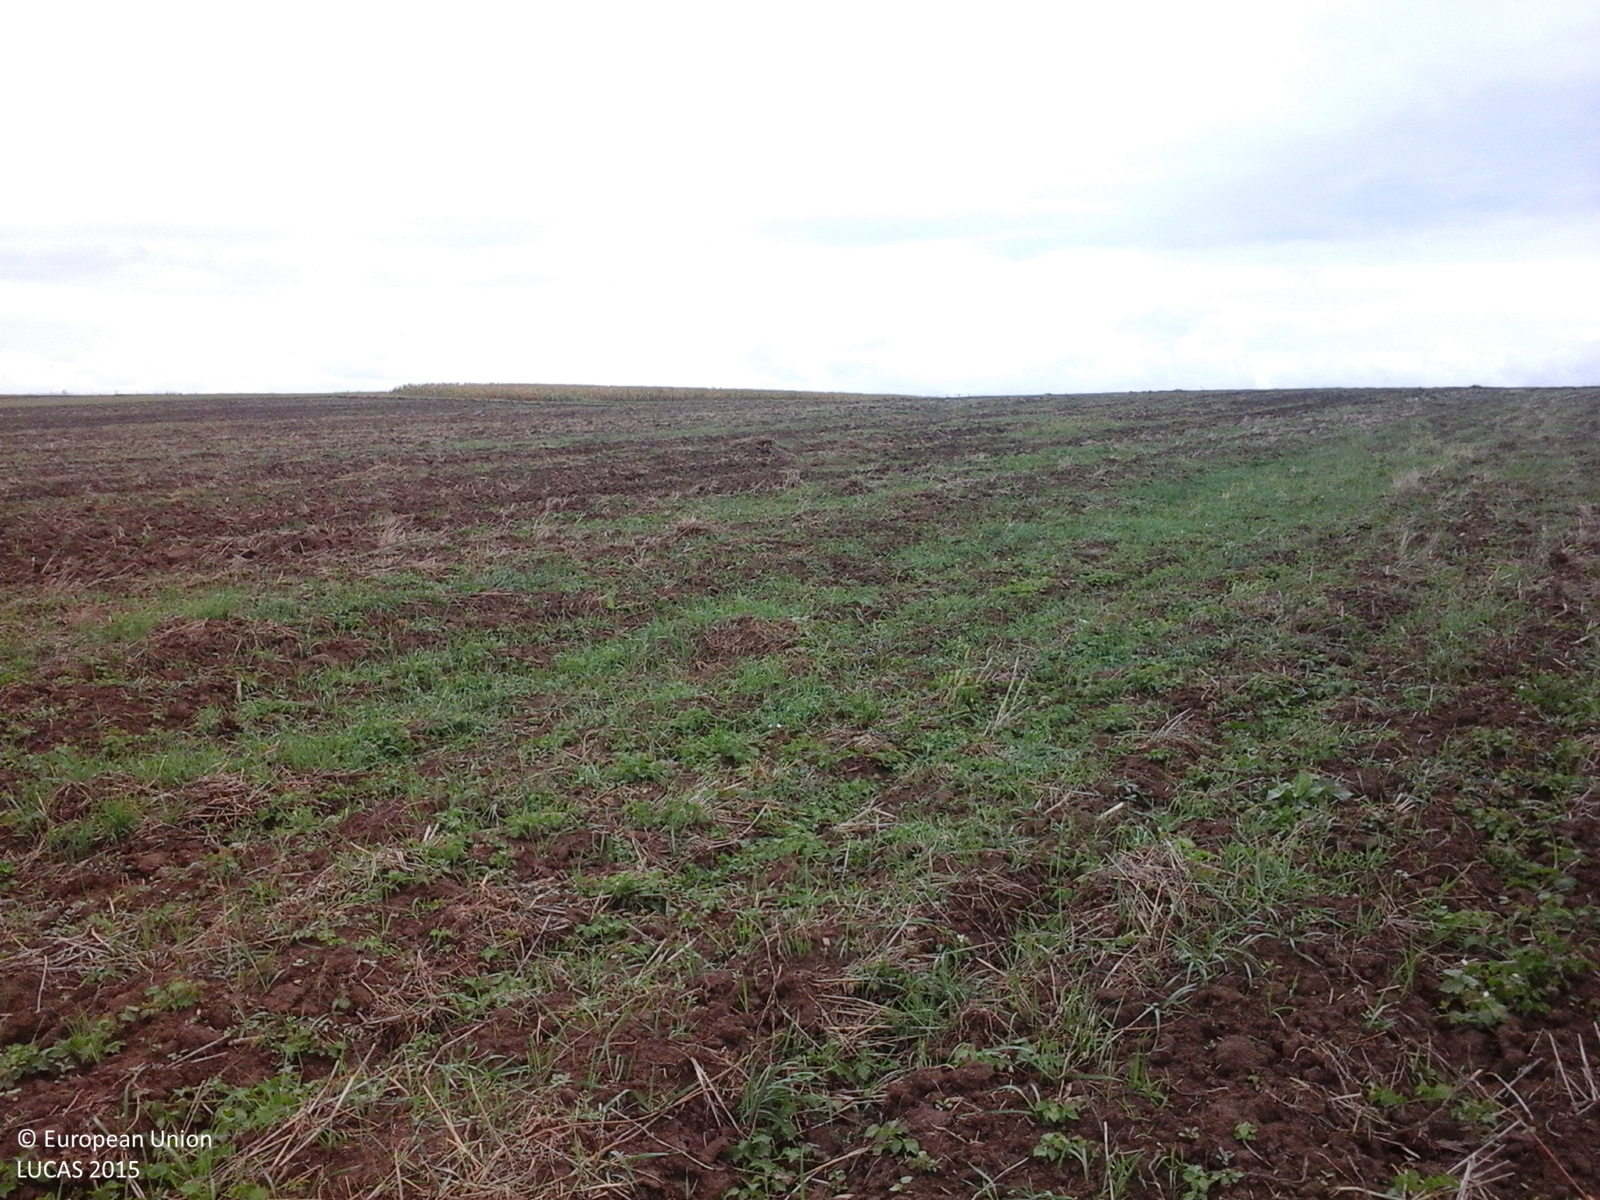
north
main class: Cropland
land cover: Common wheat
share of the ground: < 10 %
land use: Agriculture (excluding fallow land and kitchen gardens)
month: September
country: RO
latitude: 46.8708
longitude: 21.8652
